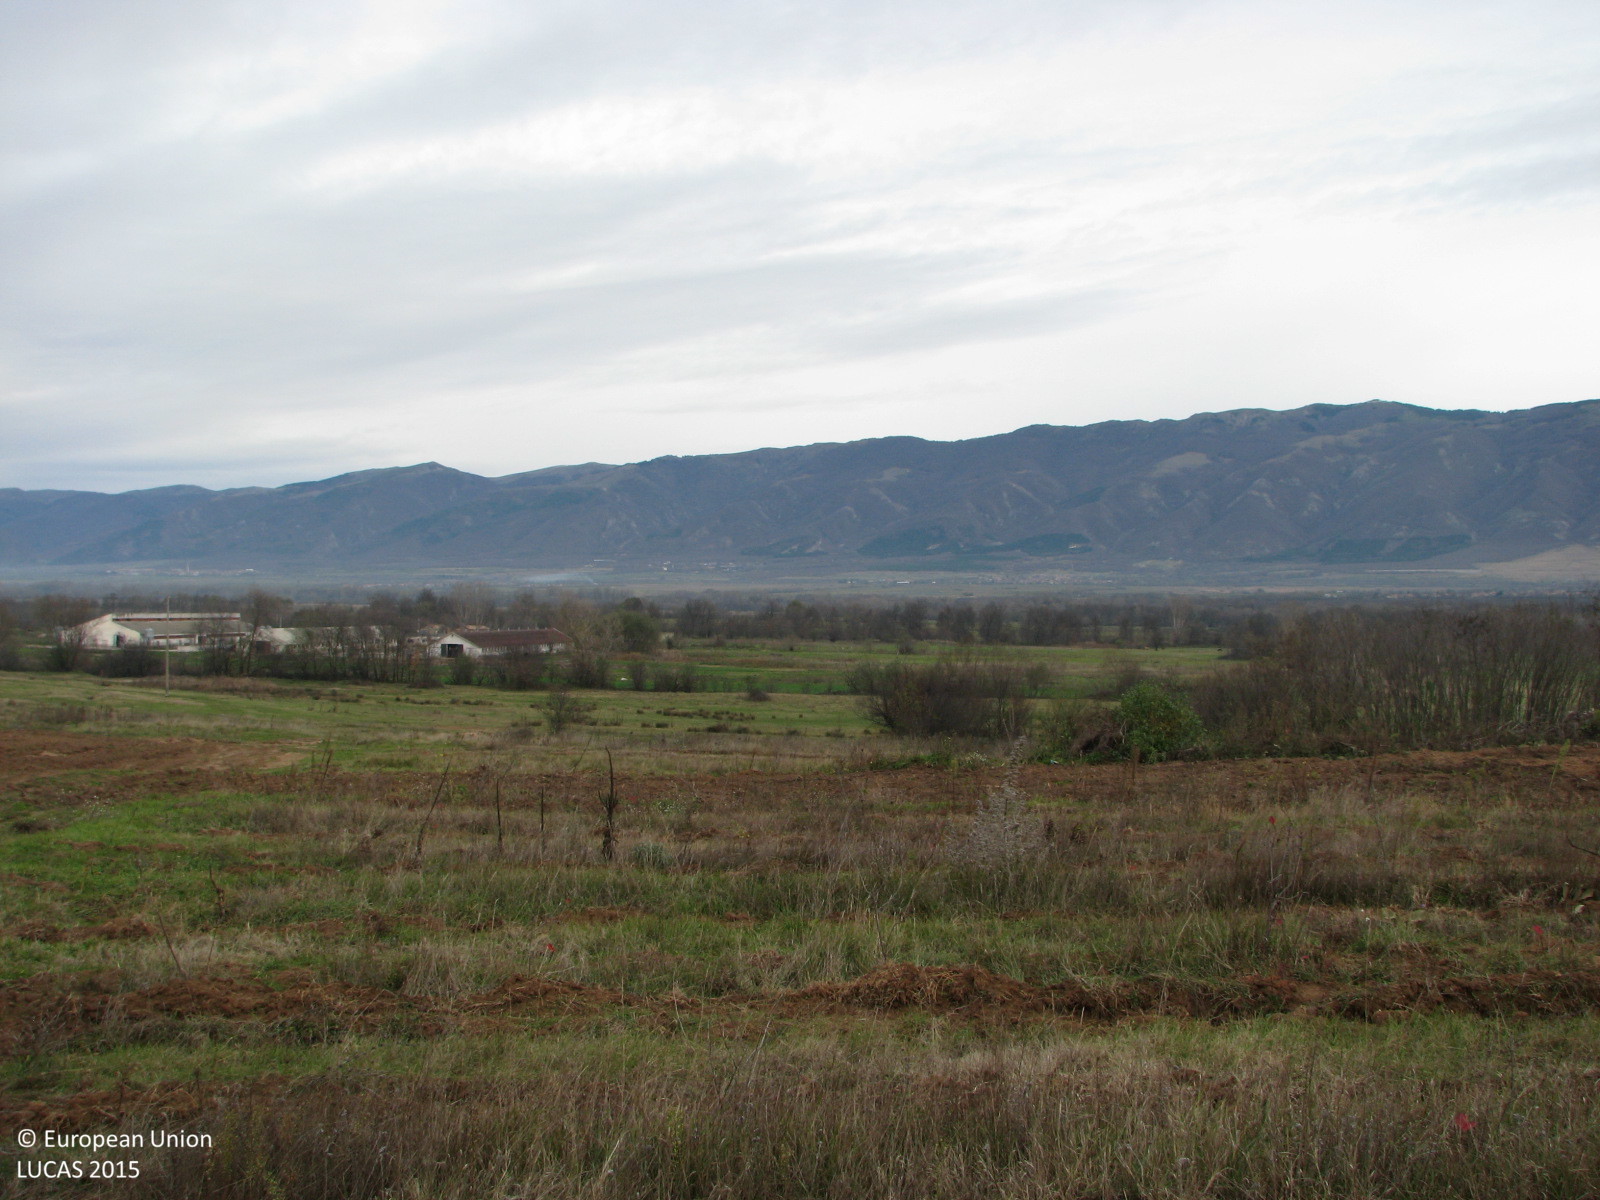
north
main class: Cropland
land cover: Other fruit trees and berries
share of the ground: 25 - 50 %
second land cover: Spontaneously vegetated surfaces
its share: 25 - 50 %
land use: Agriculture (excluding fallow land and kitchen gardens)
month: December
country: BG
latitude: 42.6230
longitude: 24.6743
